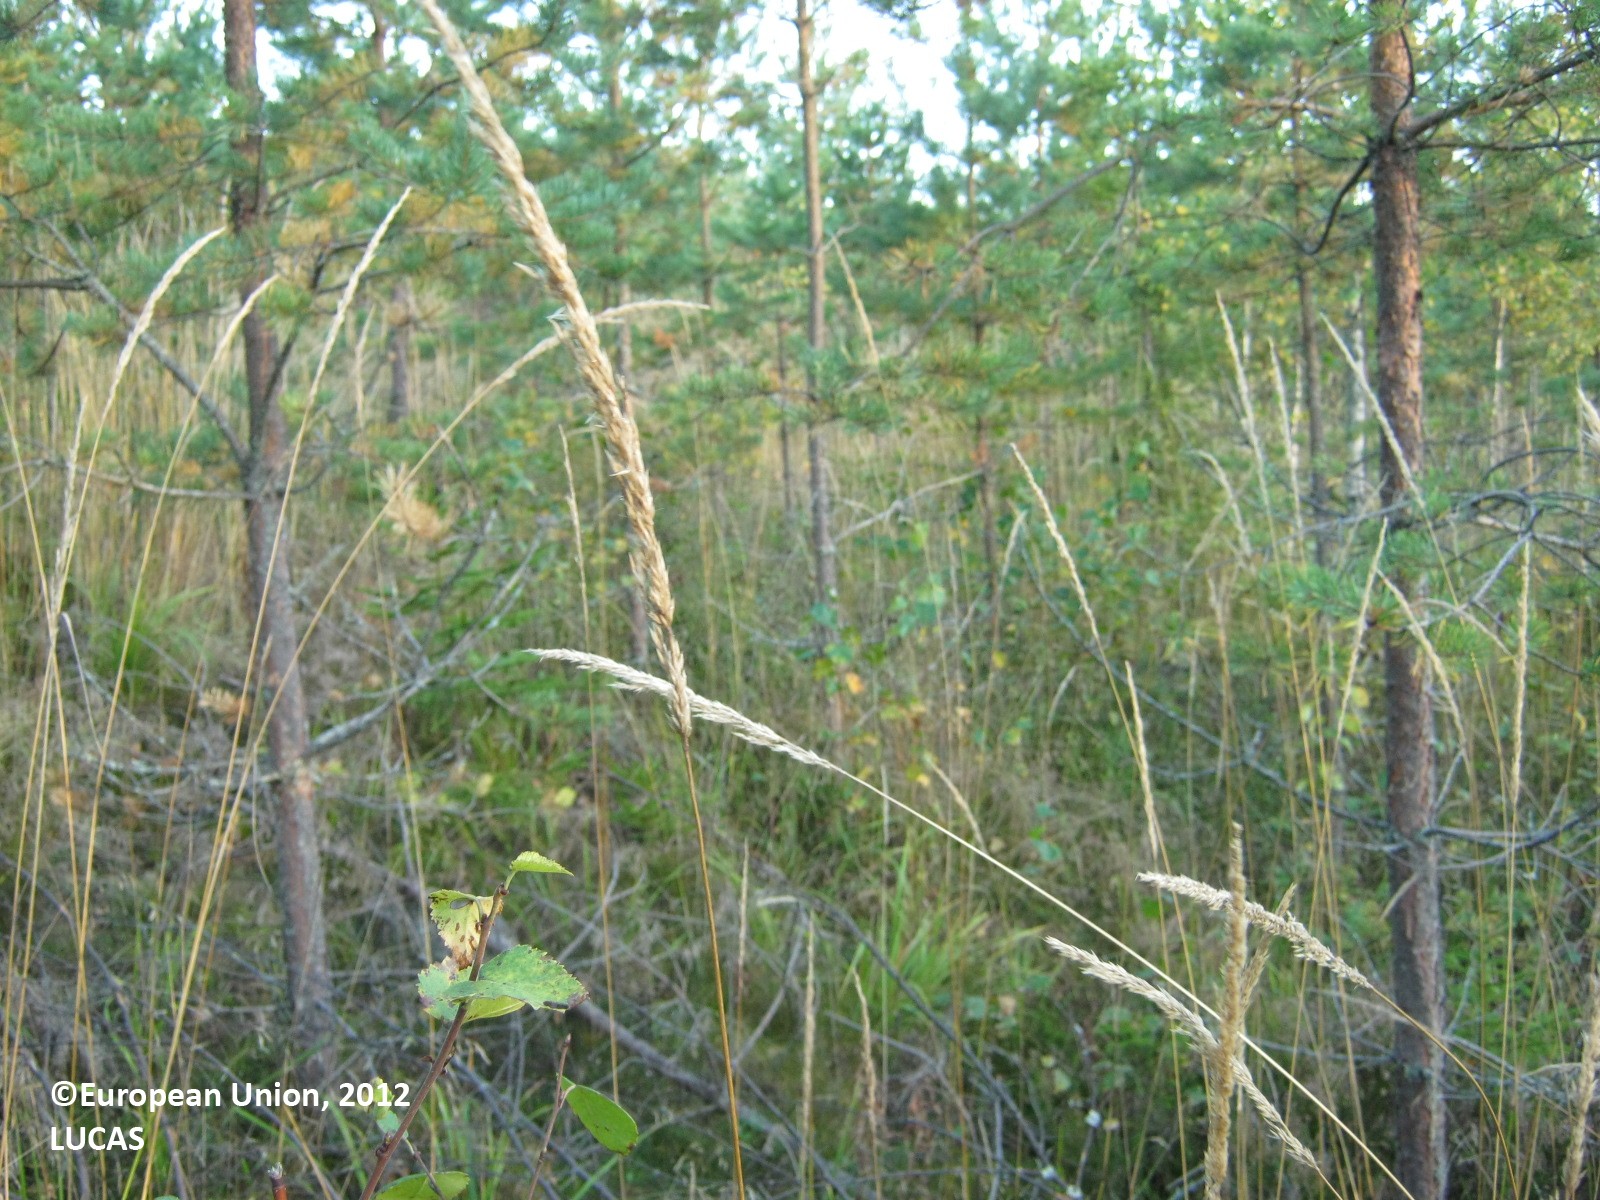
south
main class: Woodland
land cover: Pine dominated coniferous woodland
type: boreal forest
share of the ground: > 75 %
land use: Forestry
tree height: < 5 m
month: September
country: FI
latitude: 60.7750
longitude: 27.9547
